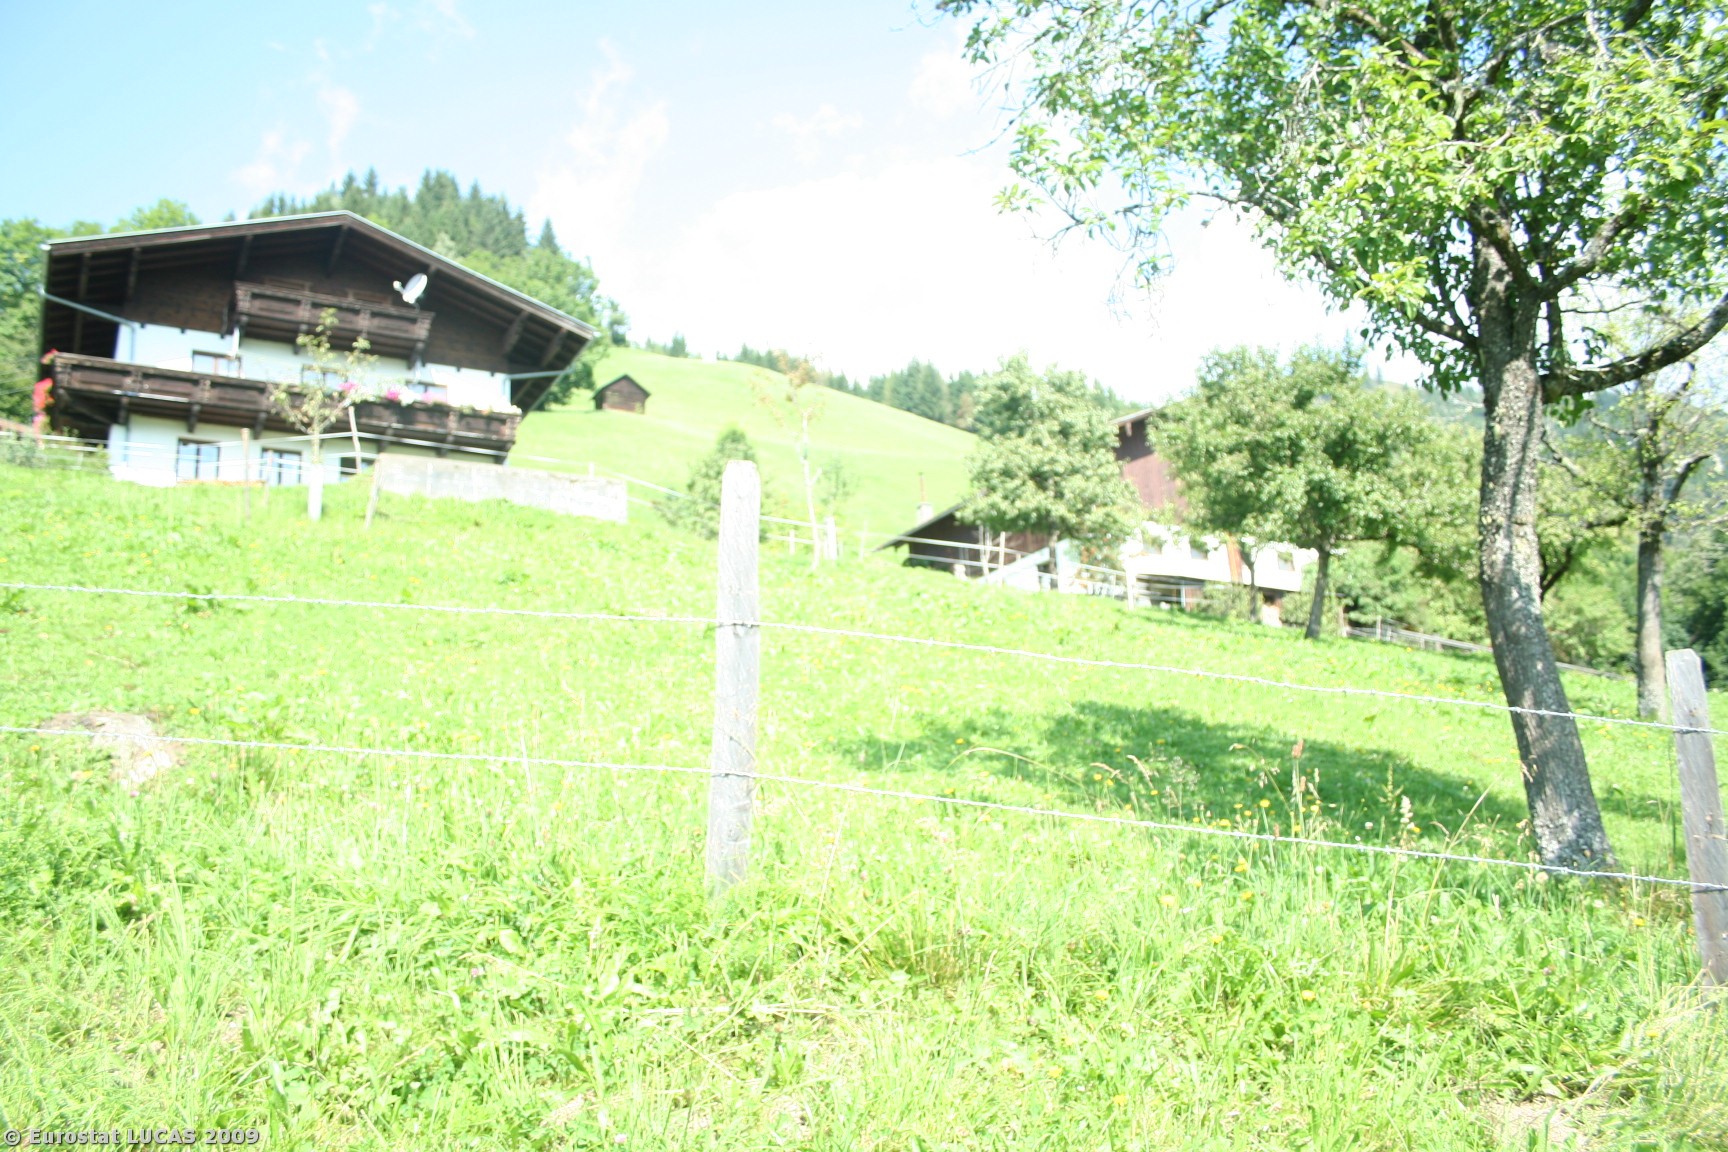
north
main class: Grassland
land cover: Grassland without tree/shrub cover
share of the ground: > 75 %
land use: Agriculture (excluding fallow land and kitchen gardens)
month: August
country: AT
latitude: 47.3669
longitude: 13.1894
